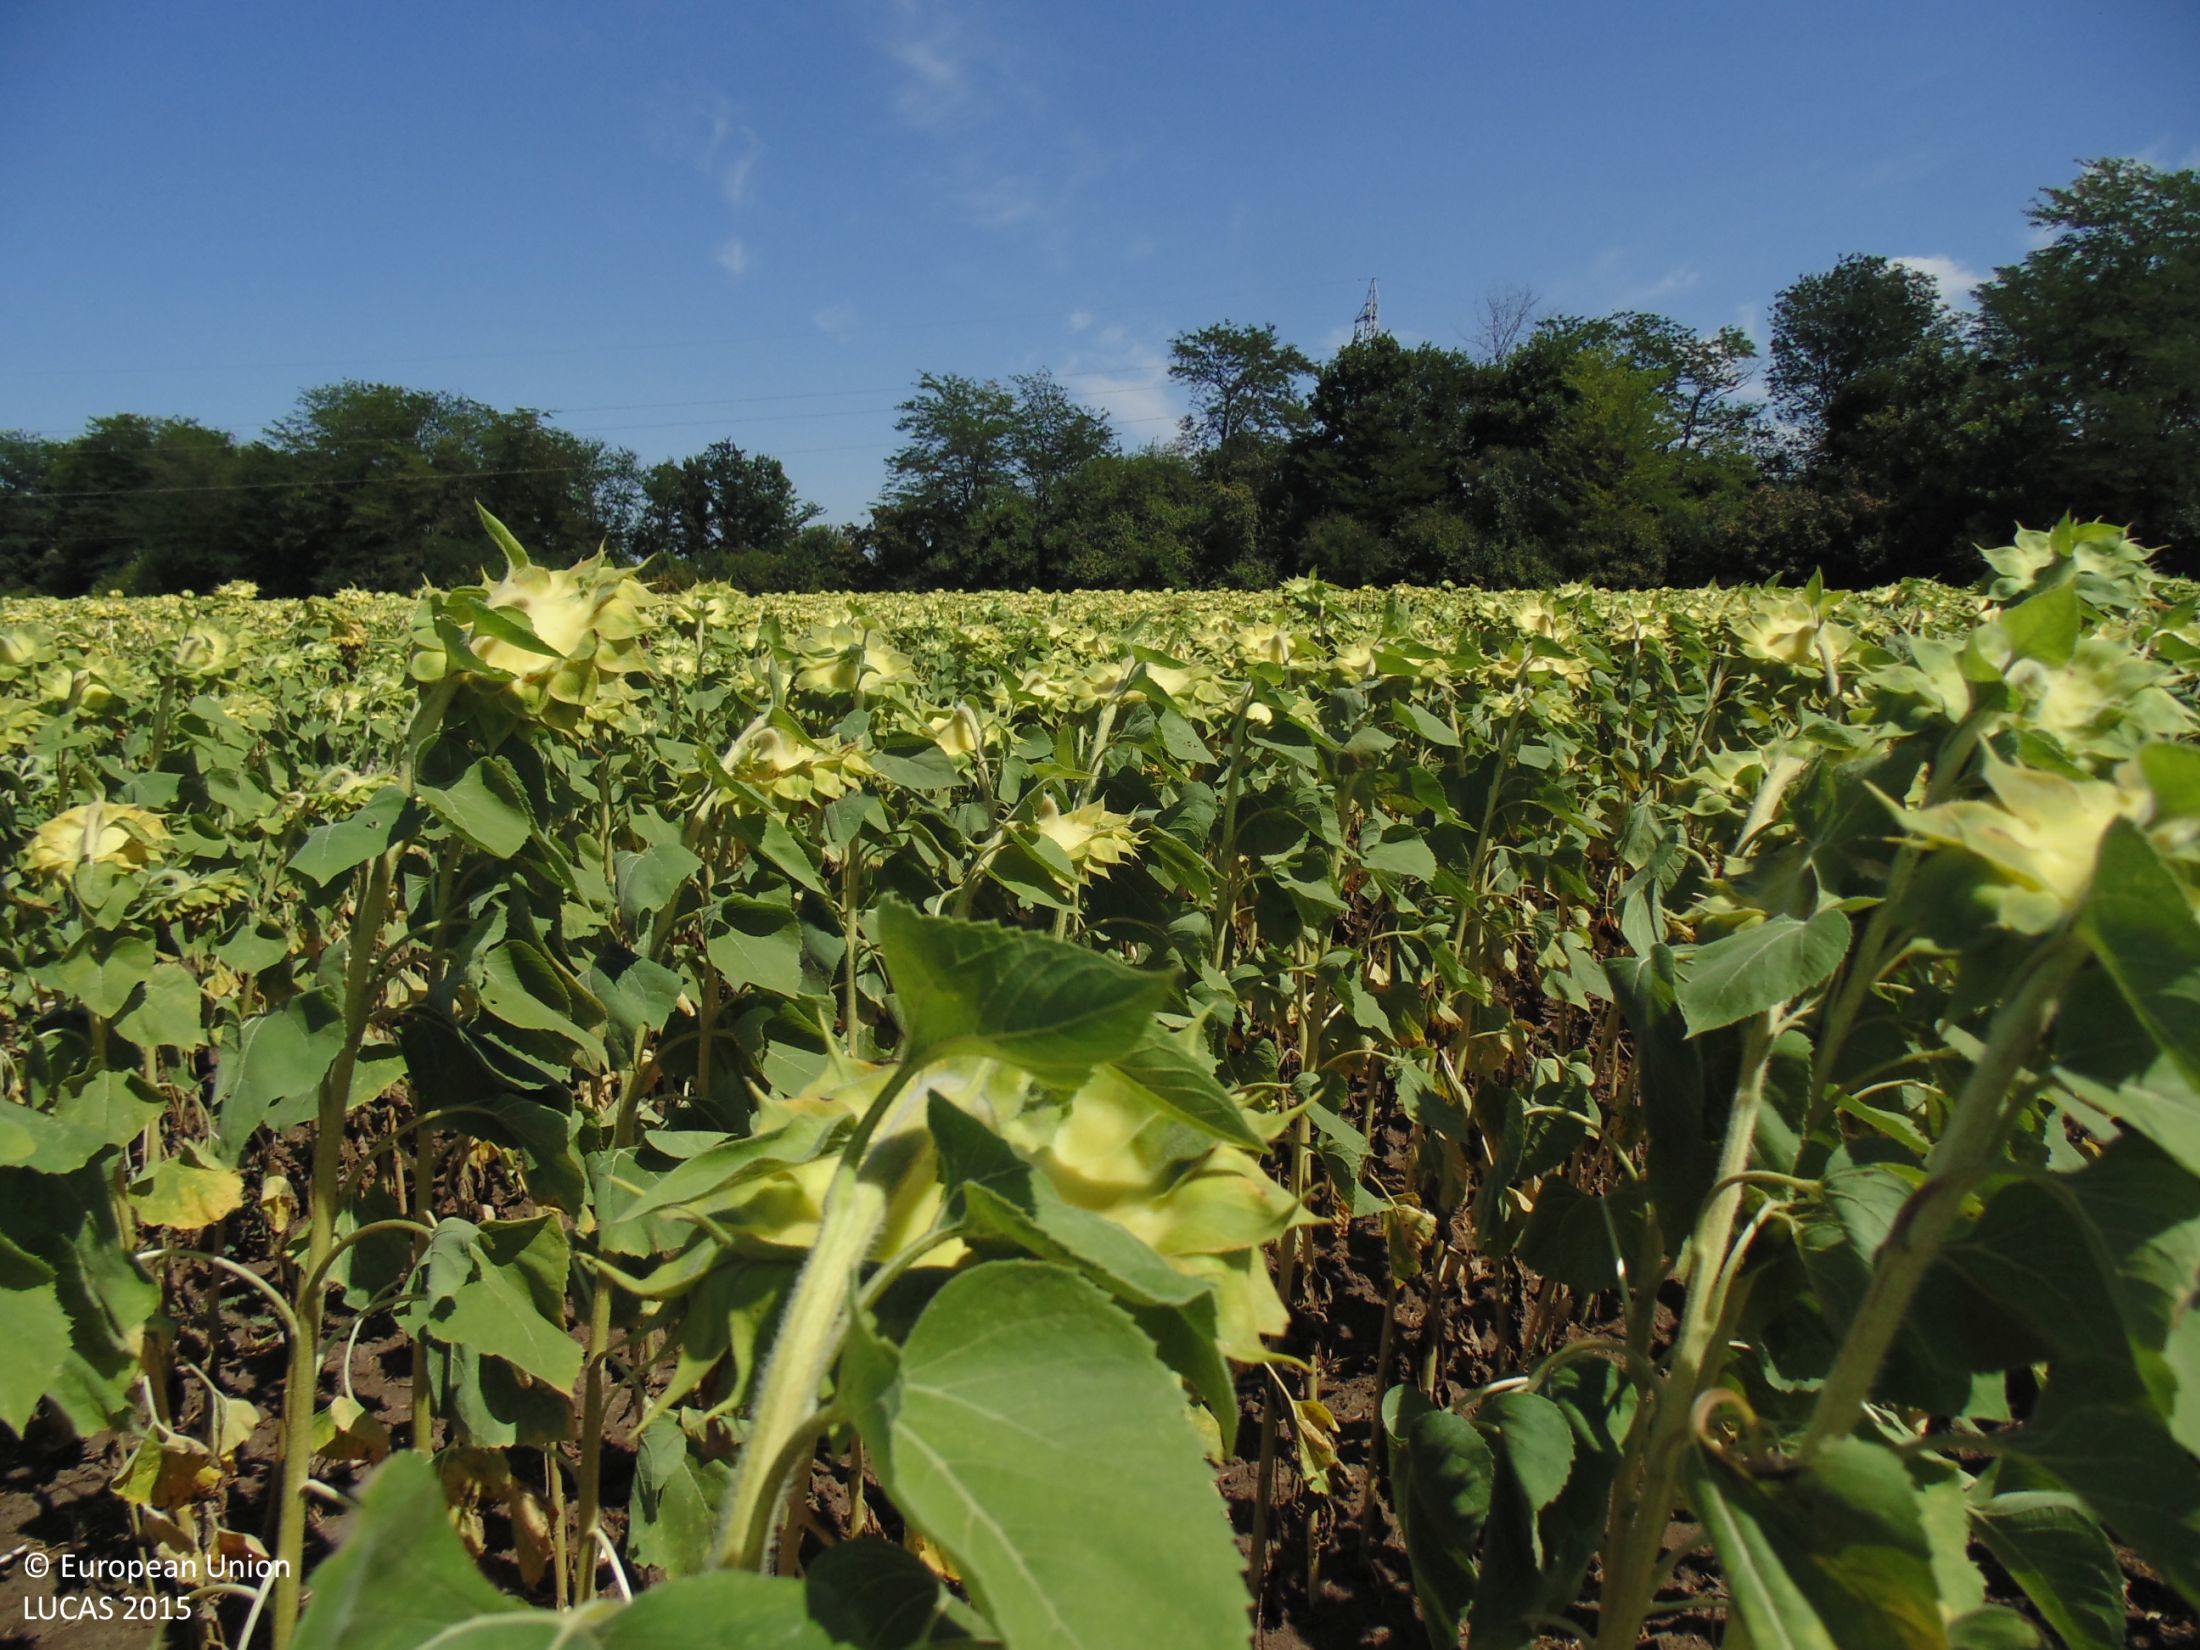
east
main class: Cropland
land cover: Sunflower
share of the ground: > 75 %
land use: Agriculture (excluding fallow land and kitchen gardens)
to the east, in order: Sunflower; Grass margins; Broadleaved woodland; Grass margins; Tracks; Grass margins; Common wheat; Electric lines; Common wheat; Electric lines; Common wheat
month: August
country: BG
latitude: 43.7999
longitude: 27.7542
